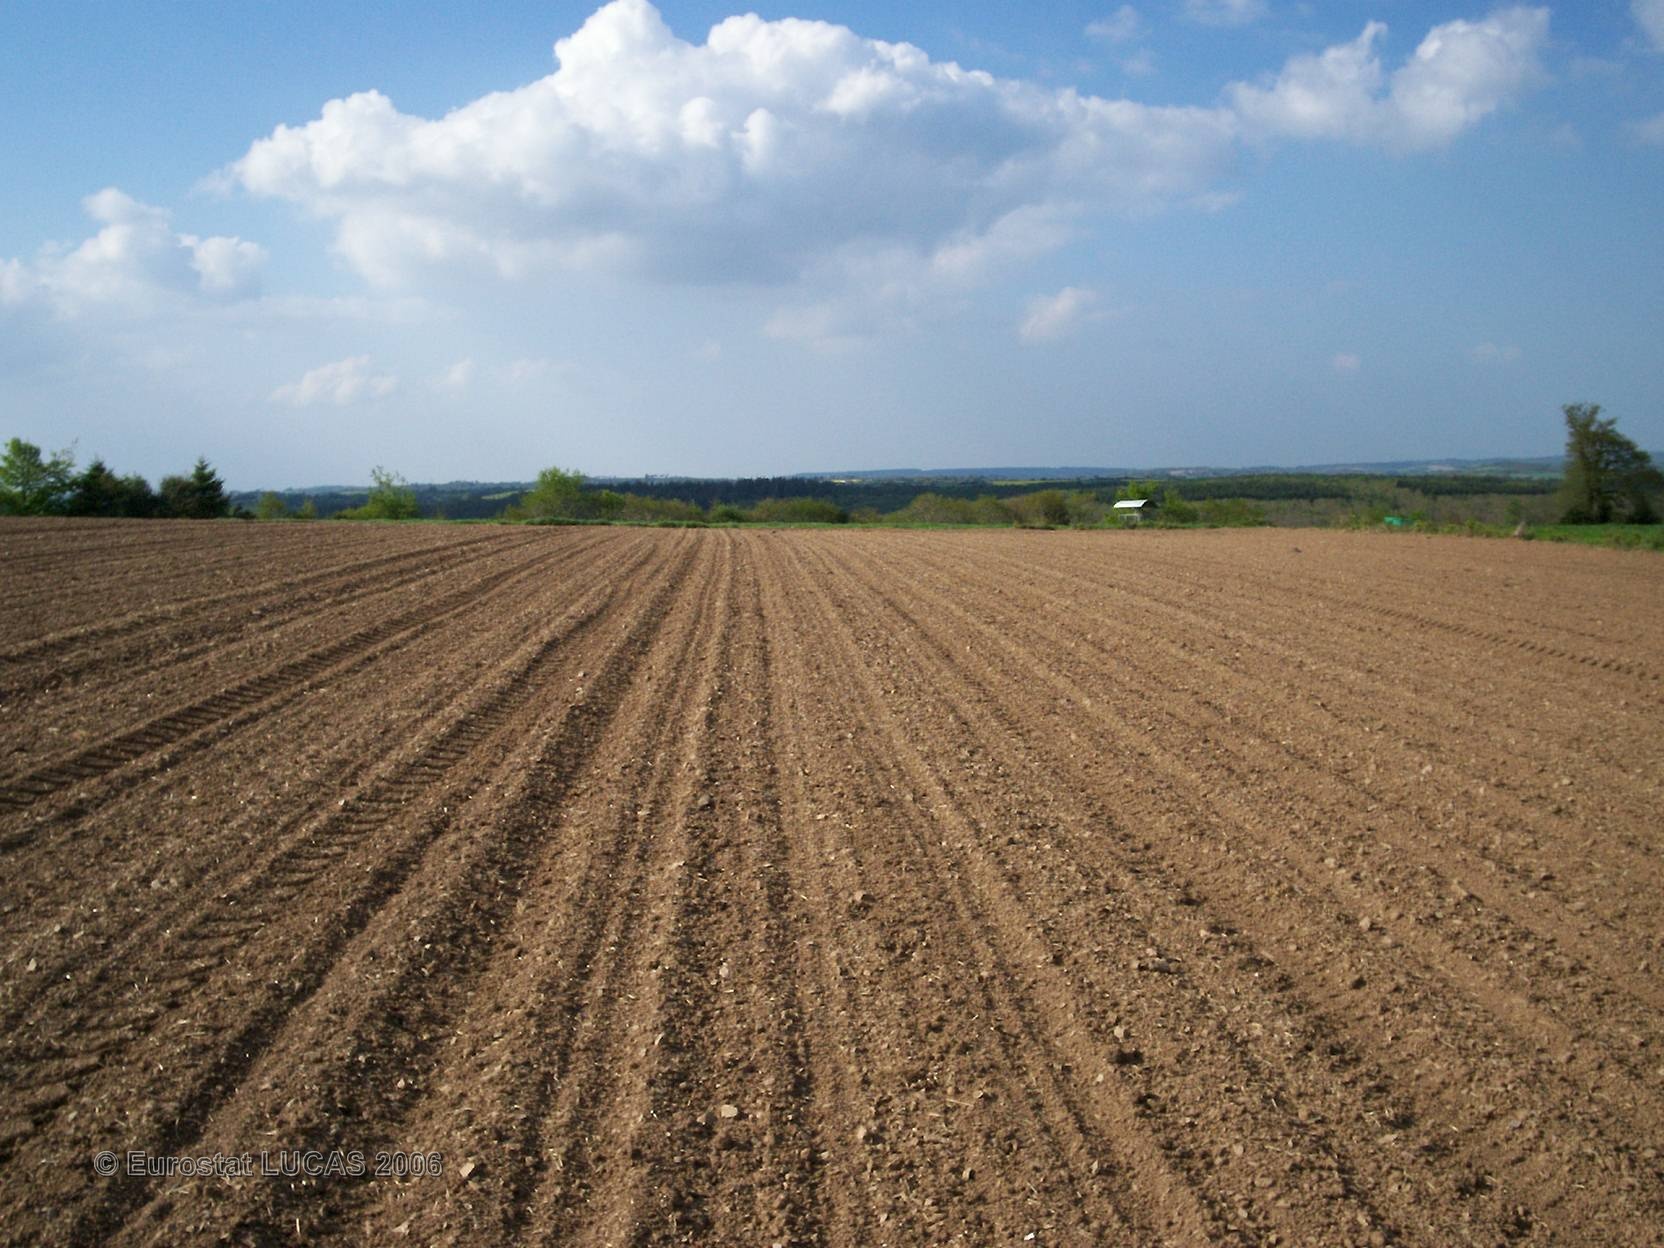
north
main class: Bare land
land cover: Bare land
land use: Agriculture (excluding fallow land and kitchen gardens)
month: May
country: FR
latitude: 48.3766
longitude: -3.6222
